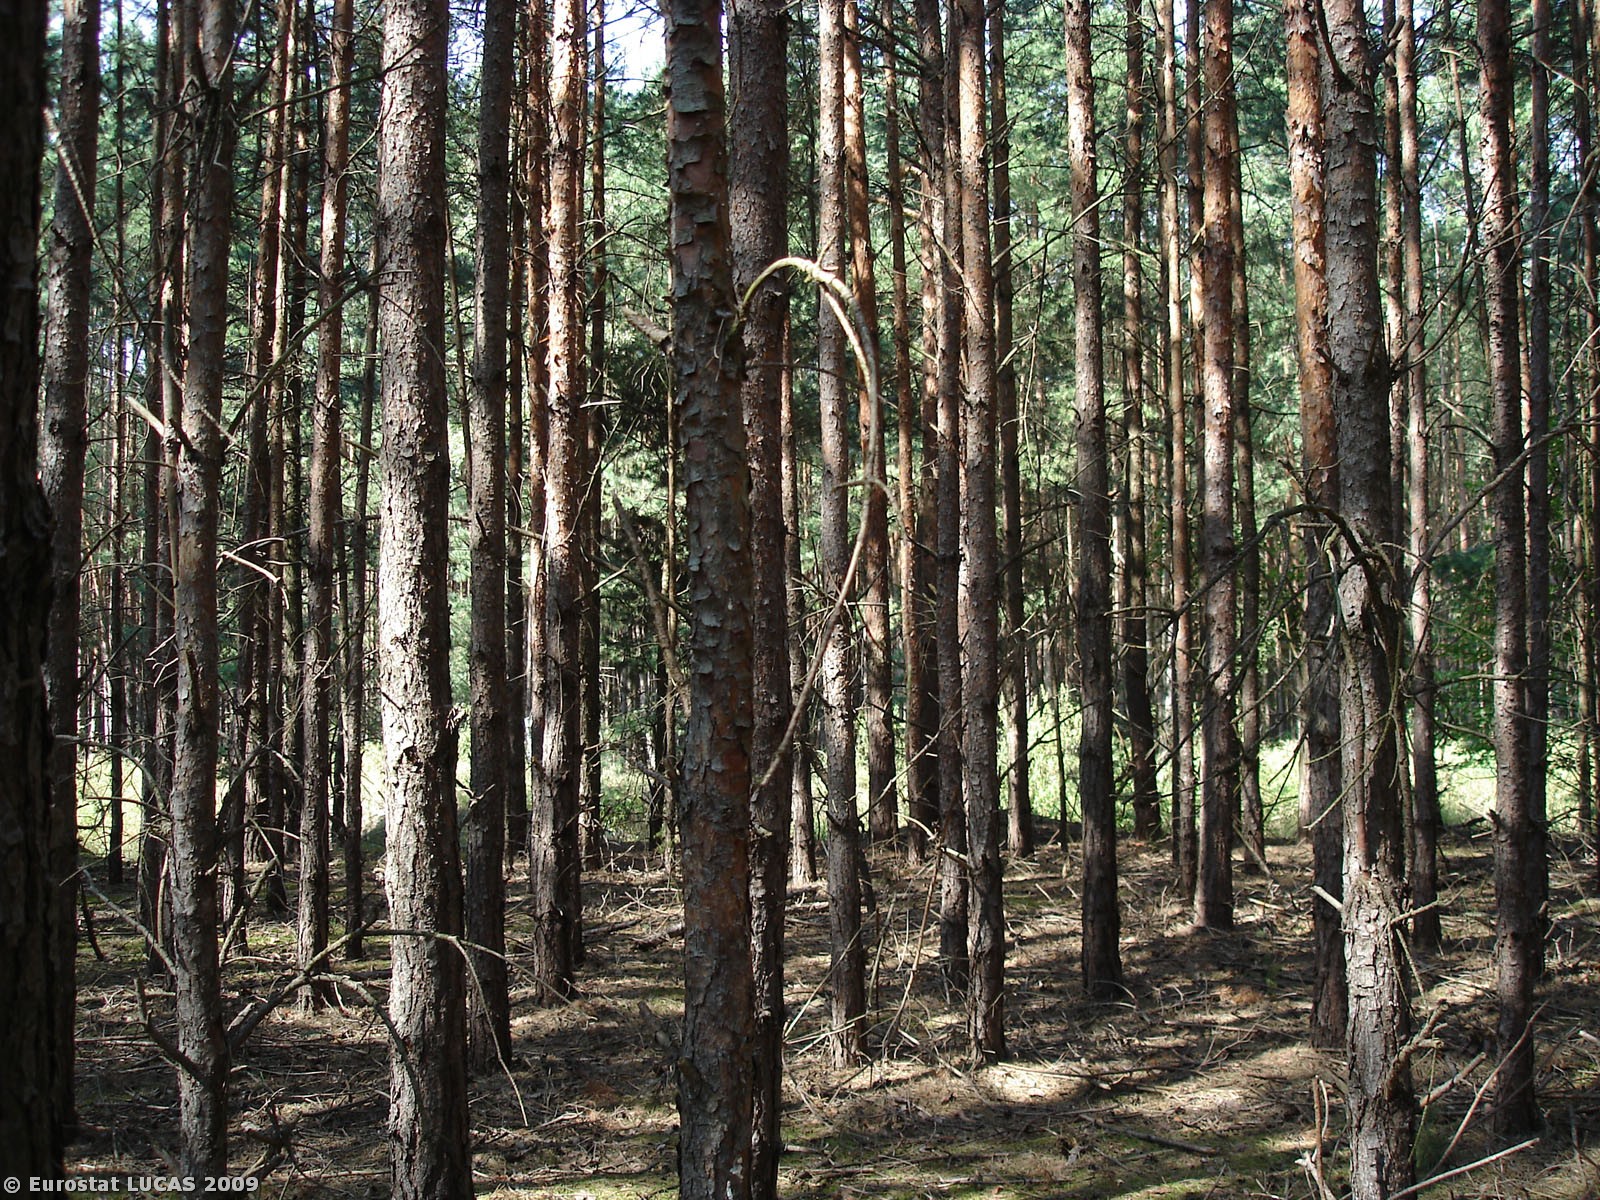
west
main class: Woodland
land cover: Coniferous woodland
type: hemiboreal forest and nemoral coniferous forest and mixed broadleaved-coniferous forest
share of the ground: > 75 %
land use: Forestry
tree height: > 5 m
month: August
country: PL
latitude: 51.0136
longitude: 18.8740
